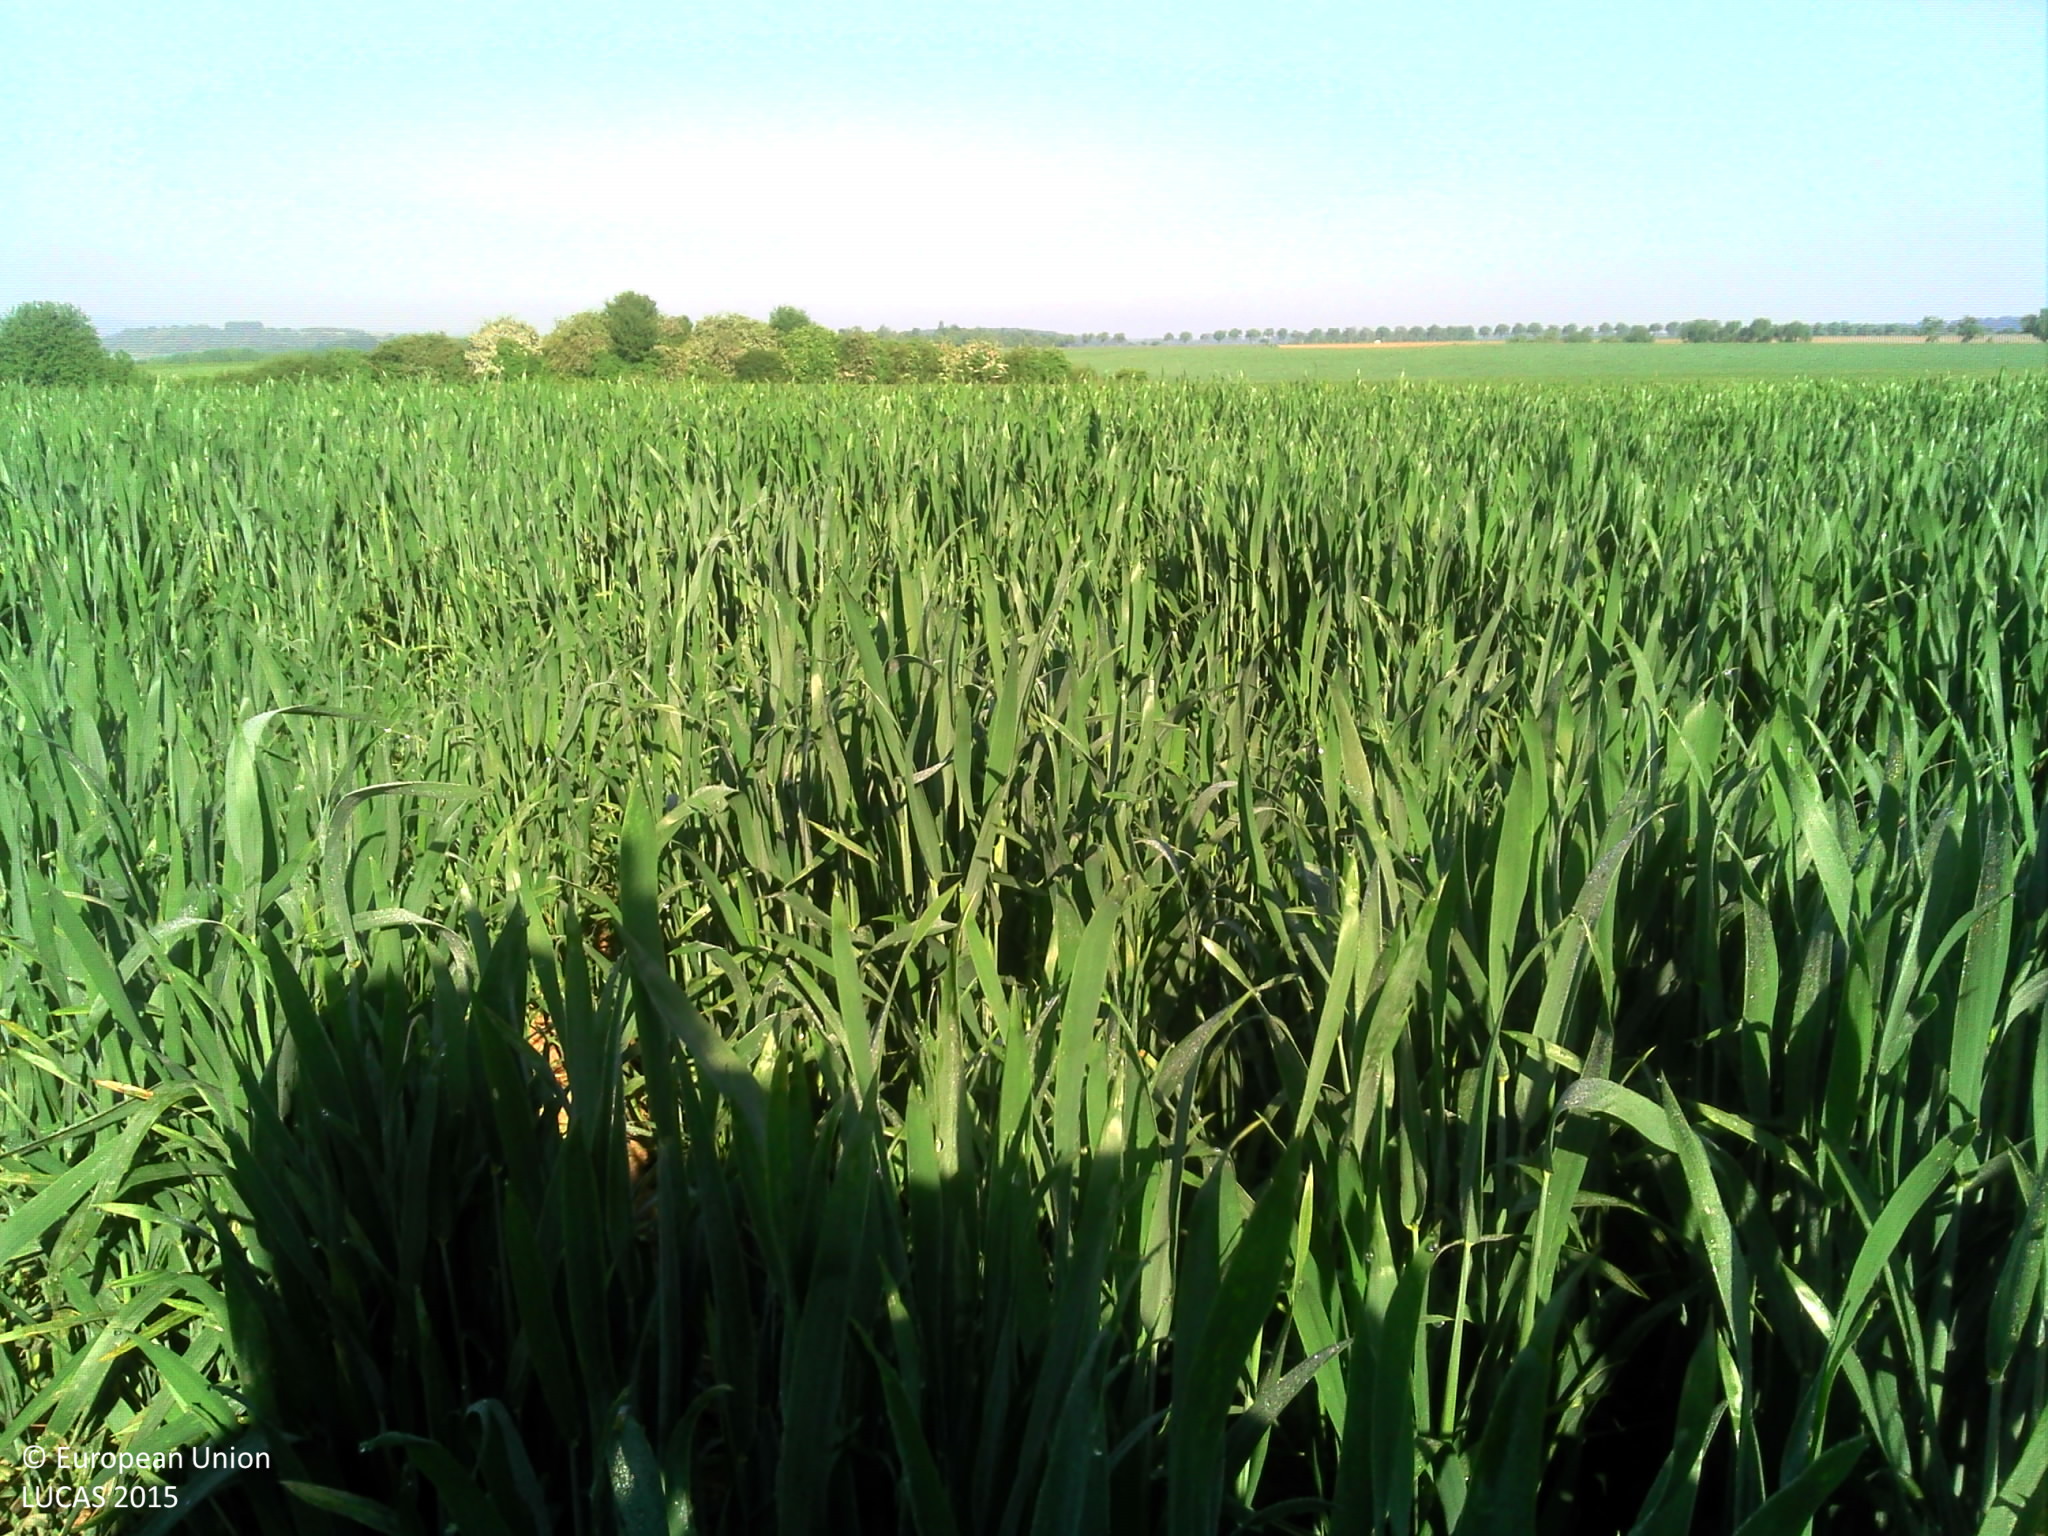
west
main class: Cropland
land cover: Common wheat
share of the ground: > 75 %
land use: Agriculture (excluding fallow land and kitchen gardens)
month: May
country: LU
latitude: 49.4946
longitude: 6.3134
